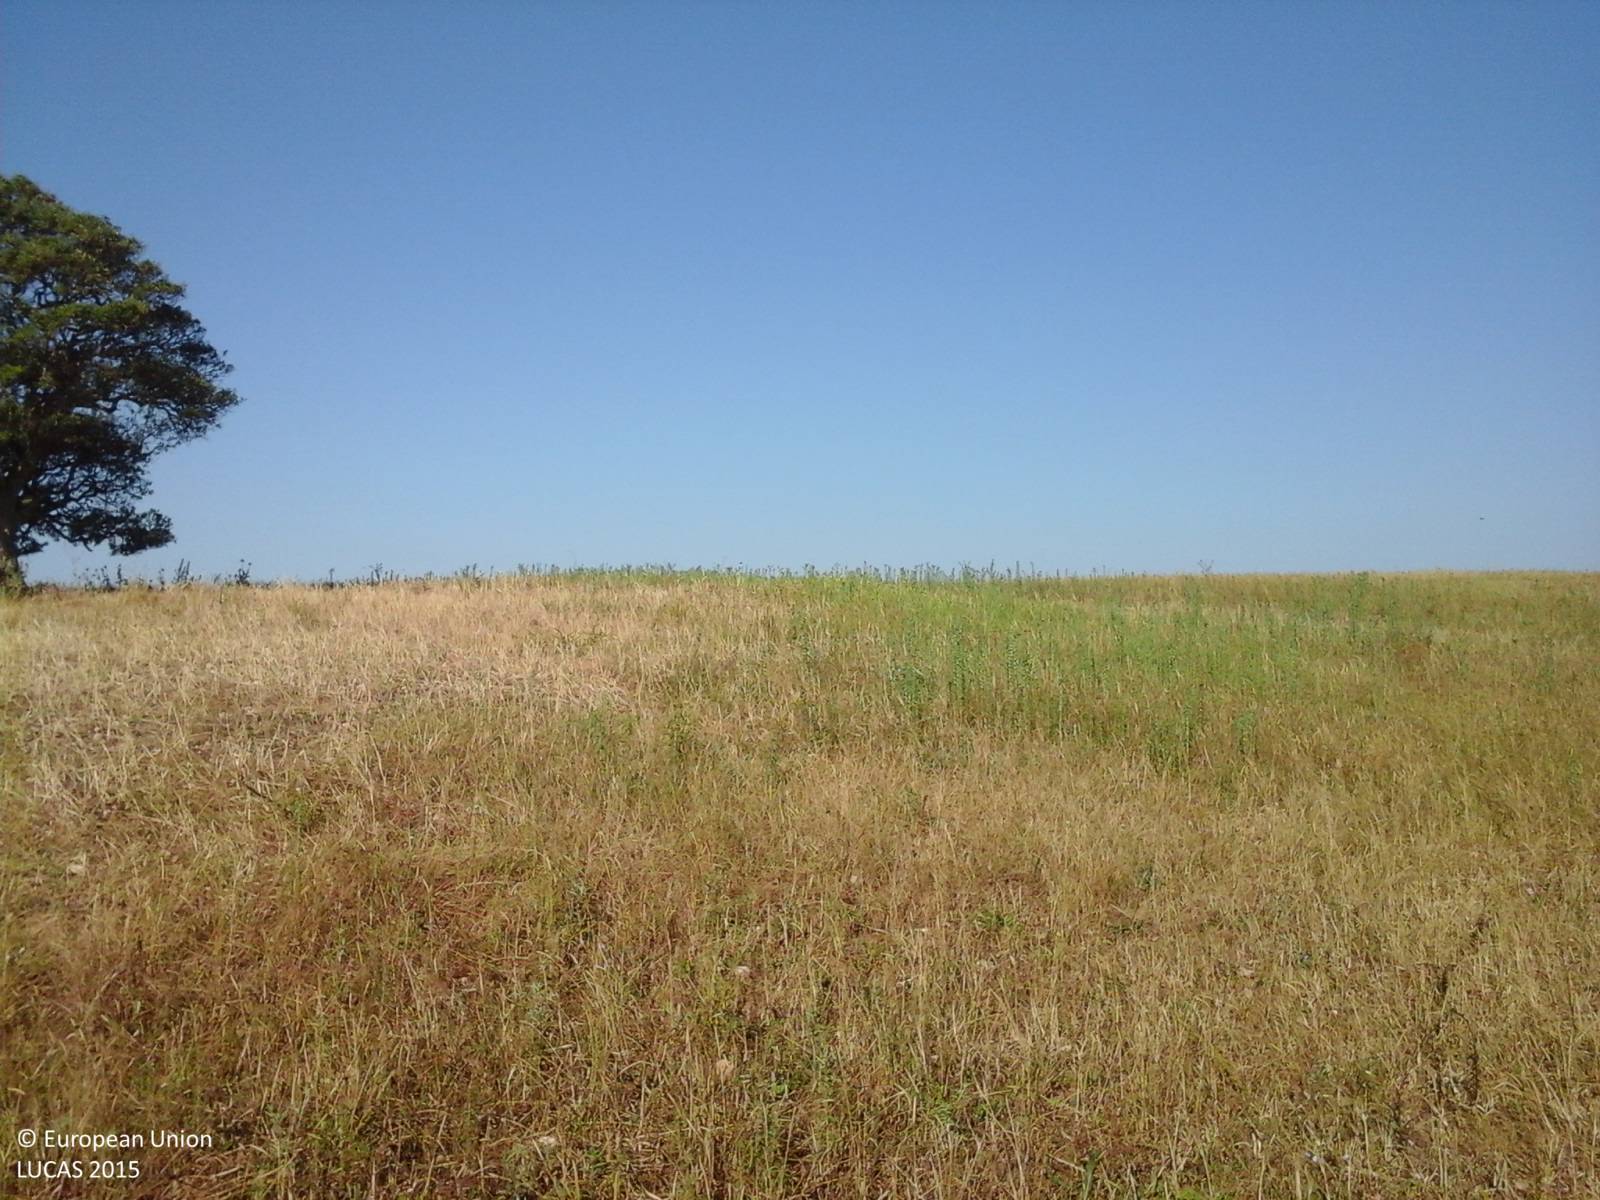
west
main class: Grassland
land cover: Grassland without tree/shrub cover
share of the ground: > 75 %
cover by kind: herbaceous plants 100 %
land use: Agriculture (excluding fallow land and kitchen gardens)
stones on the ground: < 10 %
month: June
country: IT
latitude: 40.7070
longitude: 8.4098
